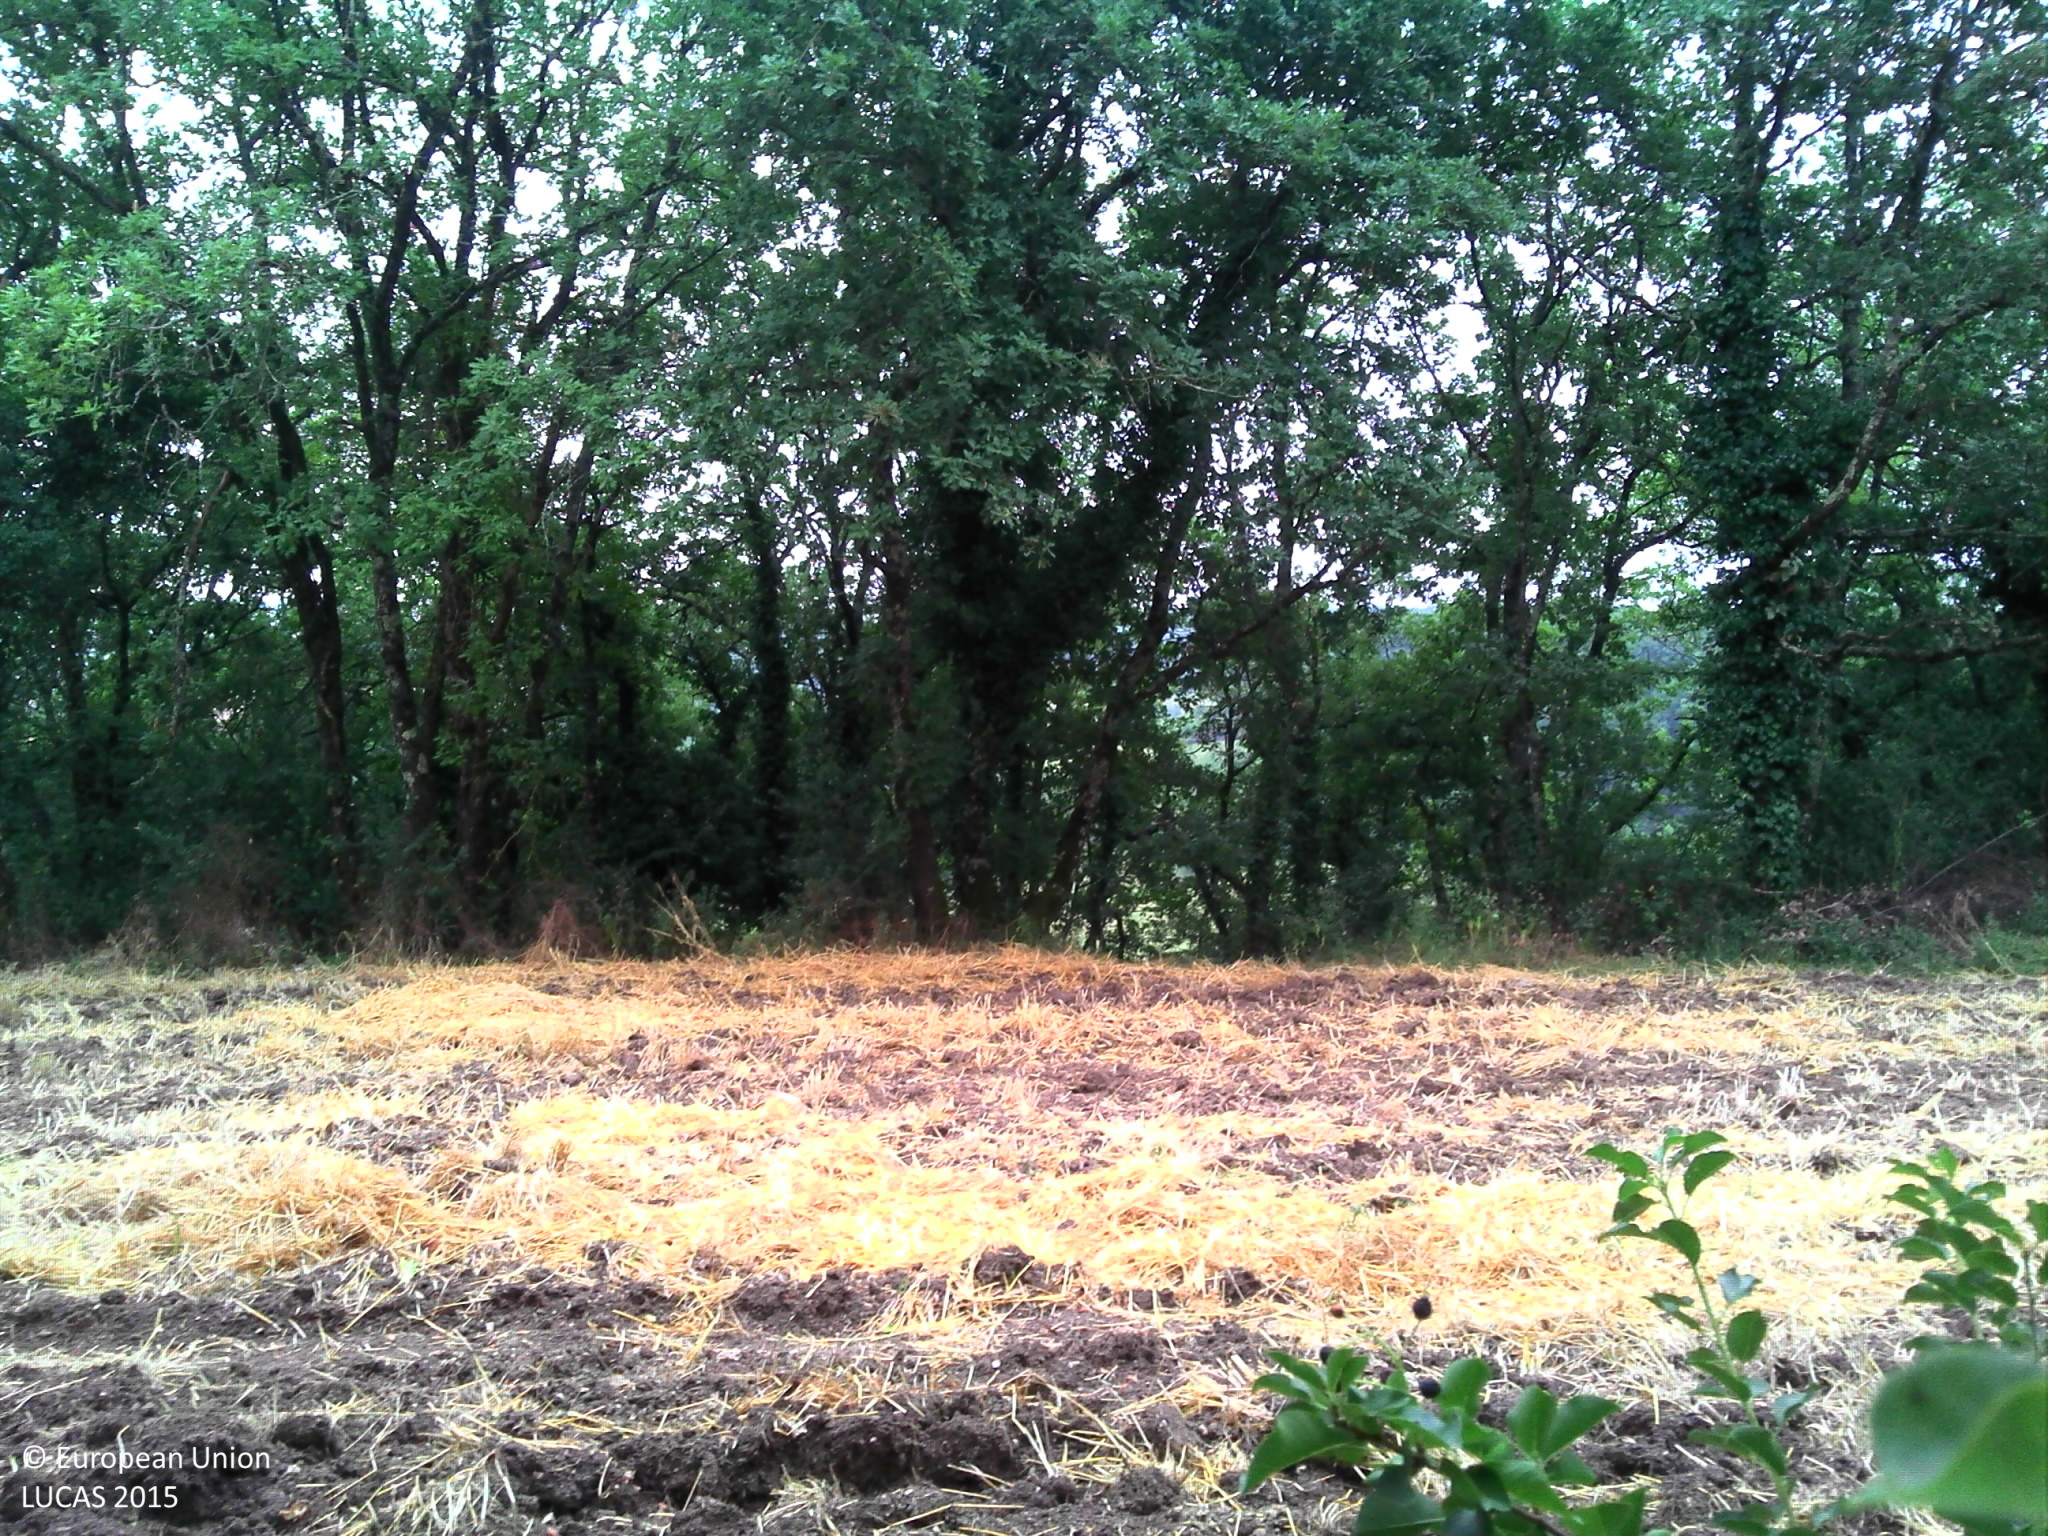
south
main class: Woodland
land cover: Broadleaved woodland
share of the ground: > 75 %
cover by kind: broadleaved forest trees 95 %, shrubs 5 %
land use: Agriculture (excluding fallow land and kitchen gardens)
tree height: > 5 m
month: July
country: FR
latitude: 44.2889
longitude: 0.8348
